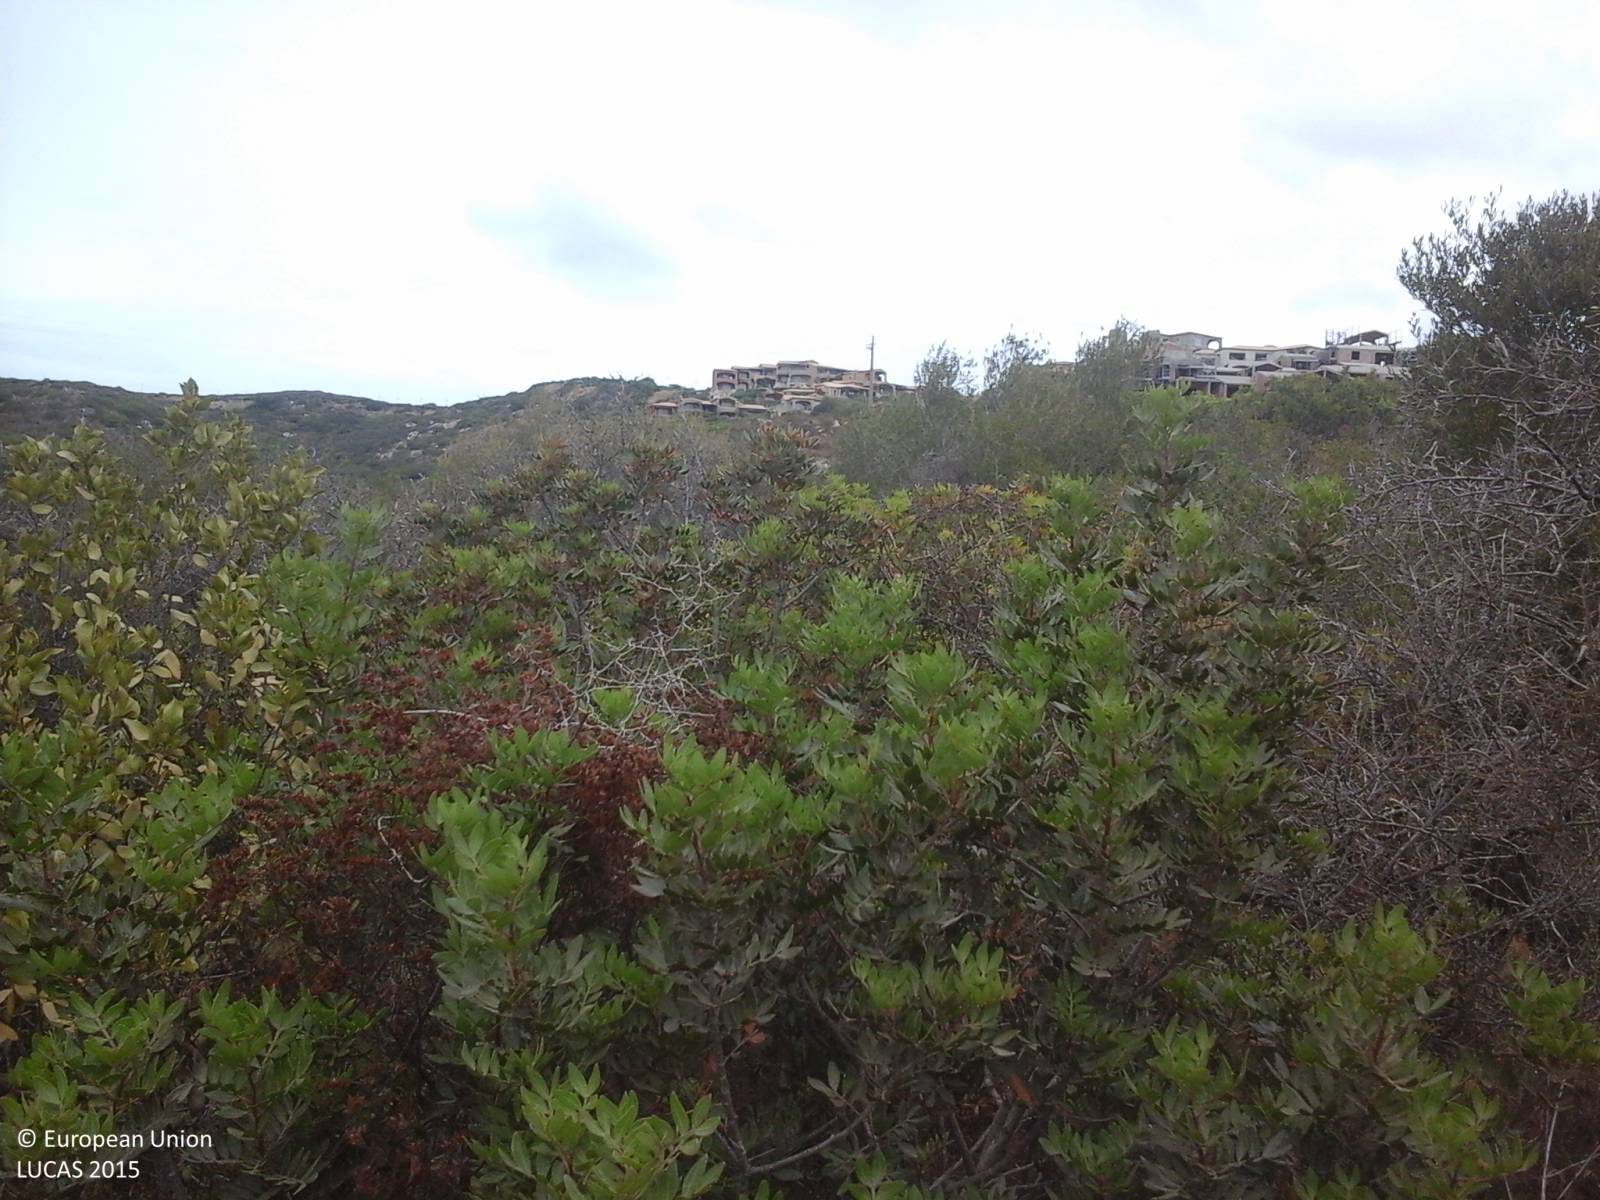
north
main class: Shrubland
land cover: Shrubland without tree cover
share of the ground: > 75 %
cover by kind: shrubs 95 %, unconsolidated bare surface 5 %
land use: Semi-natural and natural areas not in use
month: August
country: IT
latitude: 40.9903
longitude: 9.5859
